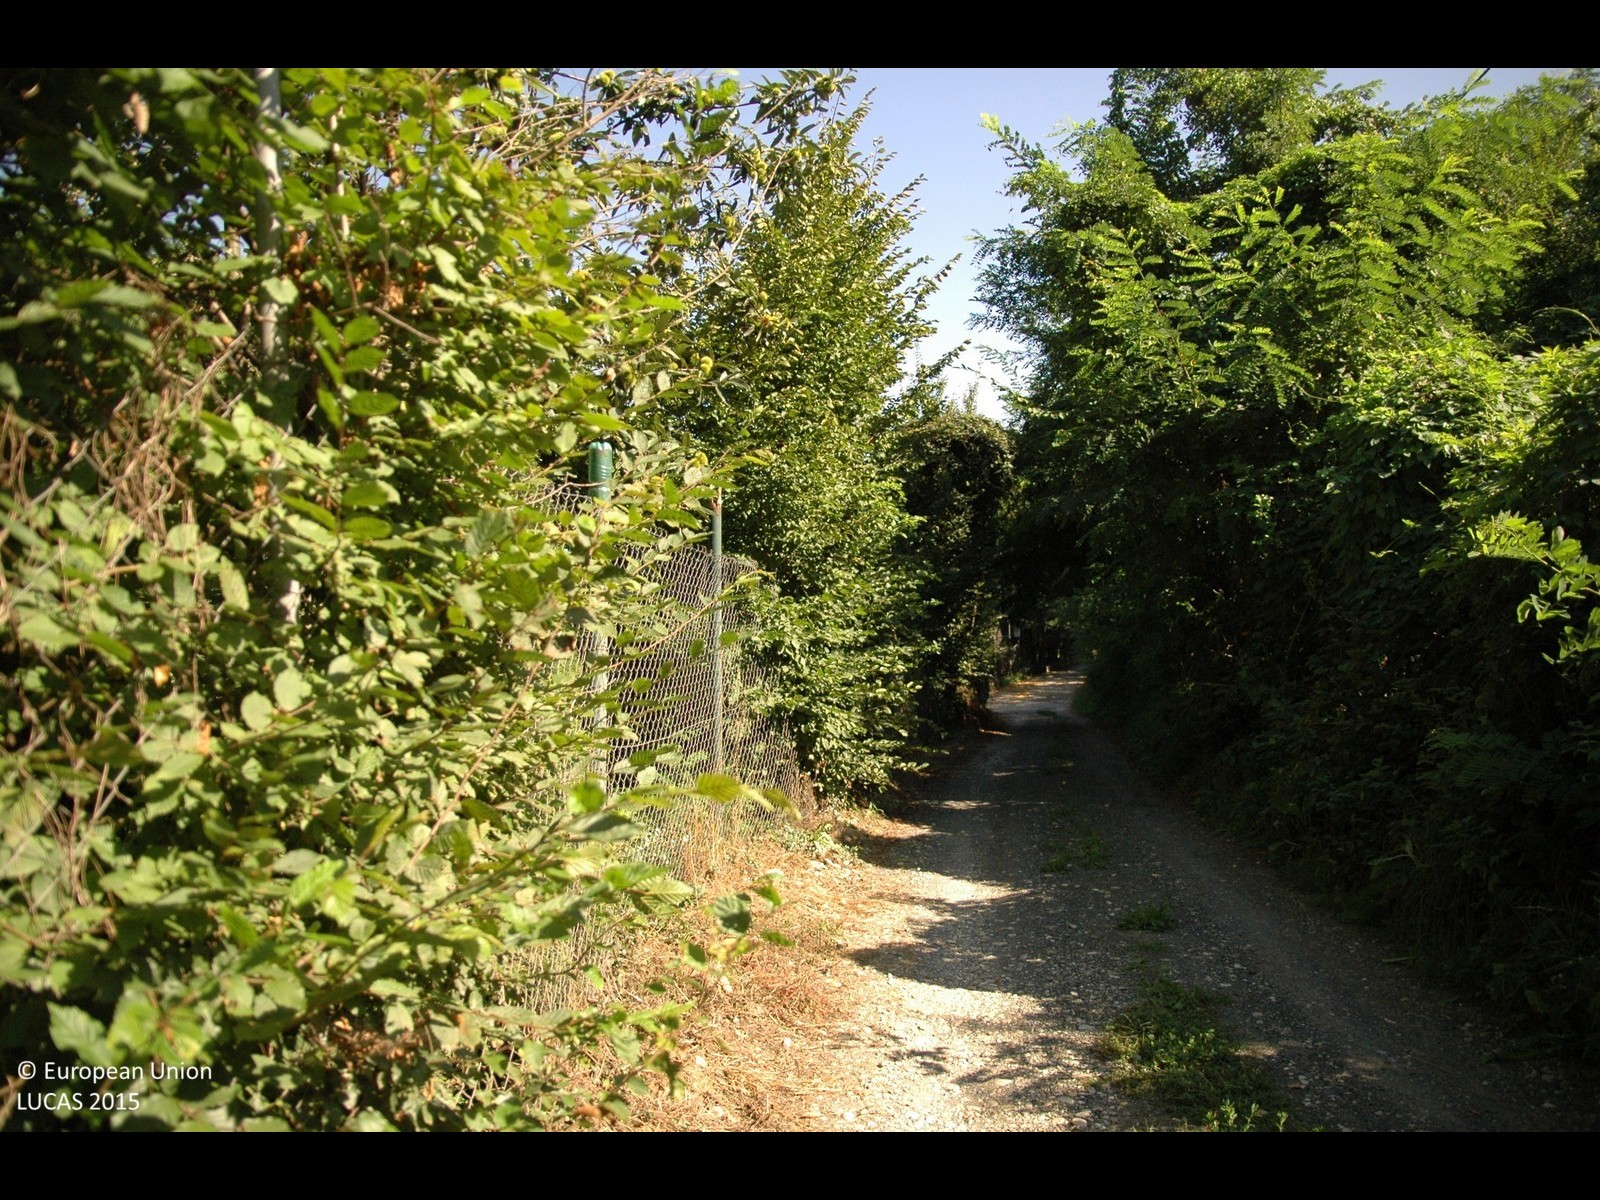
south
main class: Woodland
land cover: Broadleaved woodland
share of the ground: > 75 %
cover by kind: broadleaved forest trees 100 %
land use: Semi-natural and natural areas not in use
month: August
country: HR
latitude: 46.1724
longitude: 16.7753
